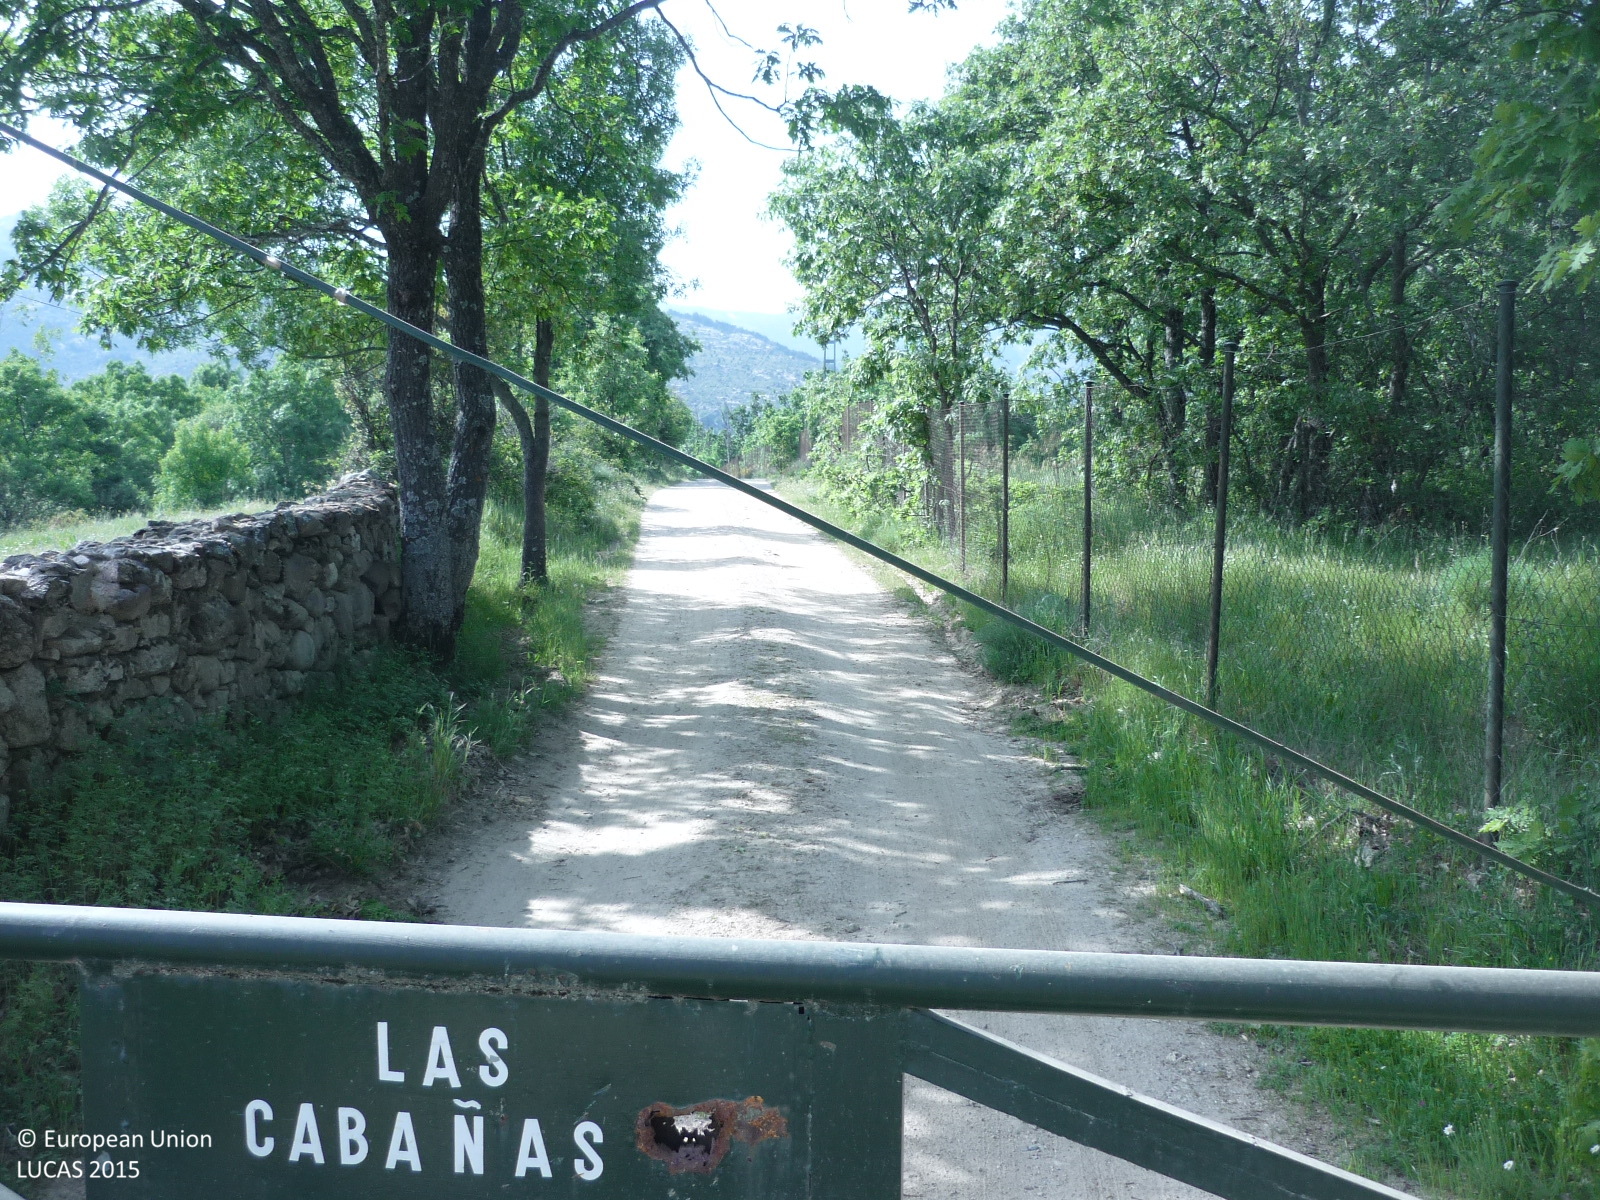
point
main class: Woodland
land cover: Broadleaved woodland
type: thermophilous deciduous forest
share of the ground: > 75 %
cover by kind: broadleaved forest trees 90 %, herbaceous plants 10 %
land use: Semi-natural and natural areas not in use
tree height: > 5 m
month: May
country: ES
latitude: 40.7855
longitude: -3.8257
